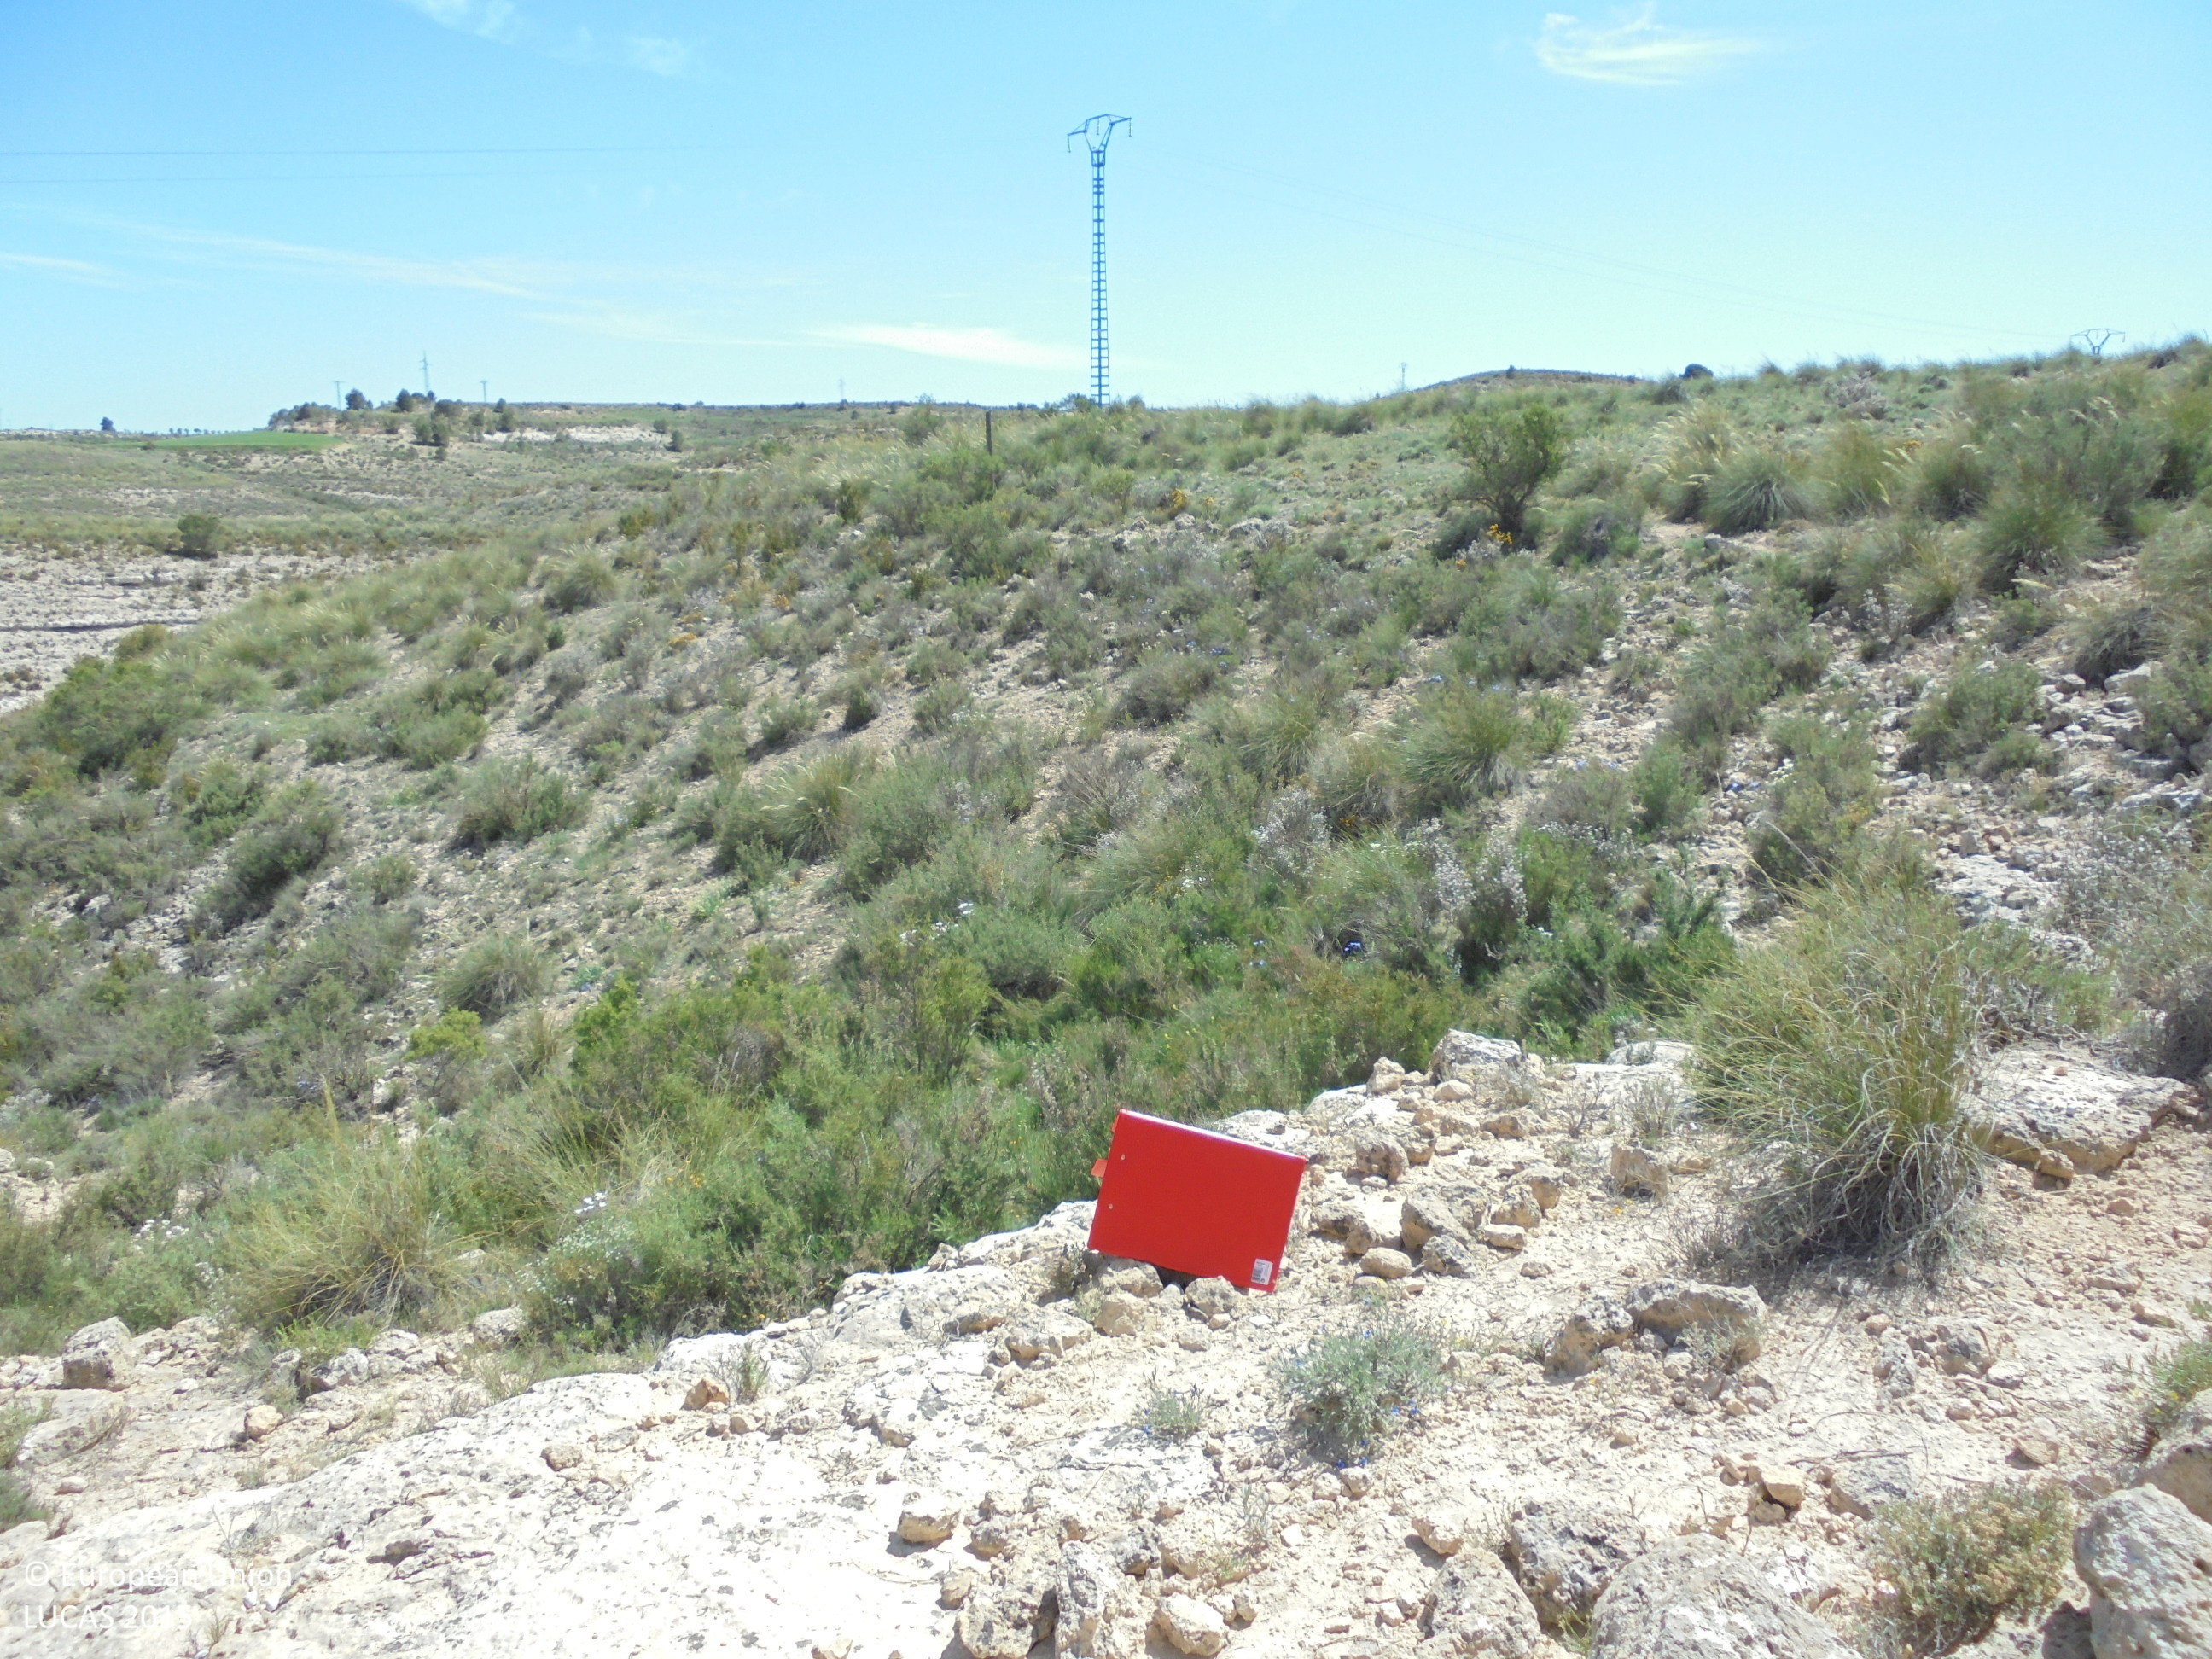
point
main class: Shrubland
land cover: Shrubland without tree cover
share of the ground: 50 - 75 %
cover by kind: shrubs 50 %, consolidated bare surface 35 %, herbaceous plants 15 %
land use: Semi-natural and natural areas not in use
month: May
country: ES
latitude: 39.1530
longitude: -1.6303
